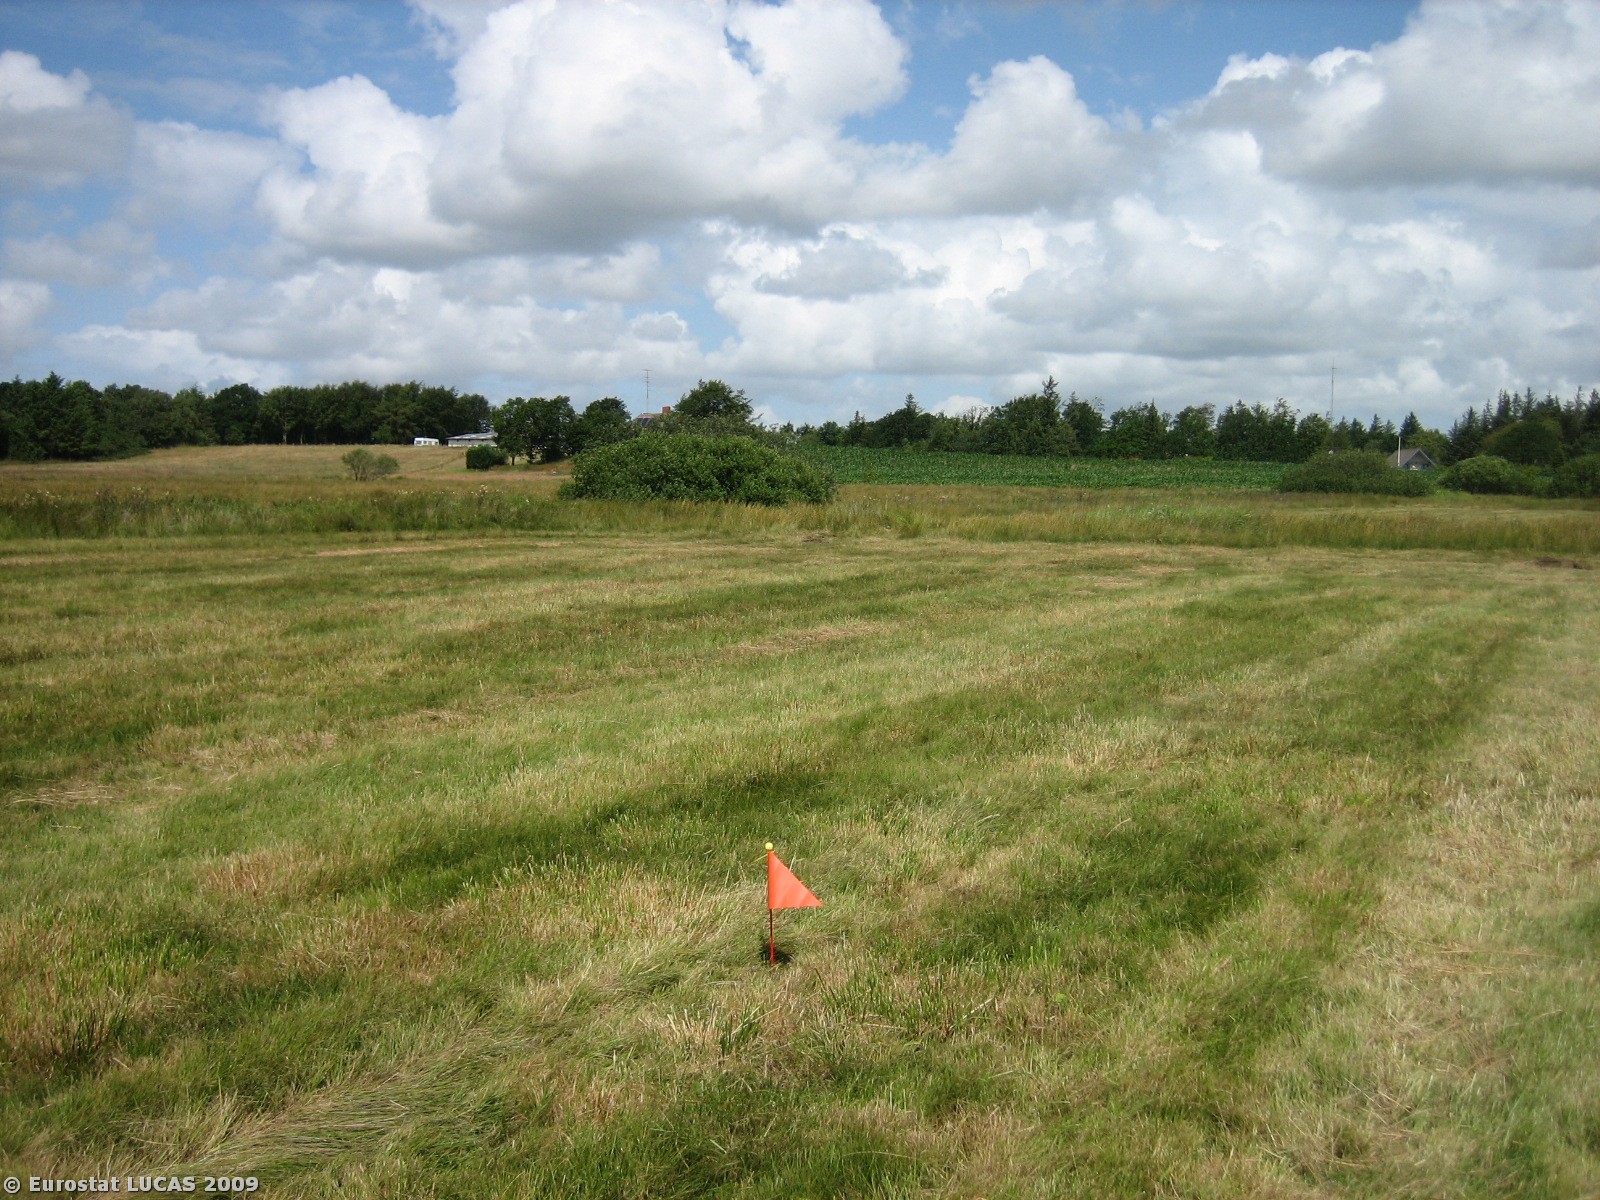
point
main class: Grassland
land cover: Grassland without tree/shrub cover
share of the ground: > 75 %
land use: Agriculture (excluding fallow land and kitchen gardens)
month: July
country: DK
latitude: 55.6208
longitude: 8.4294
